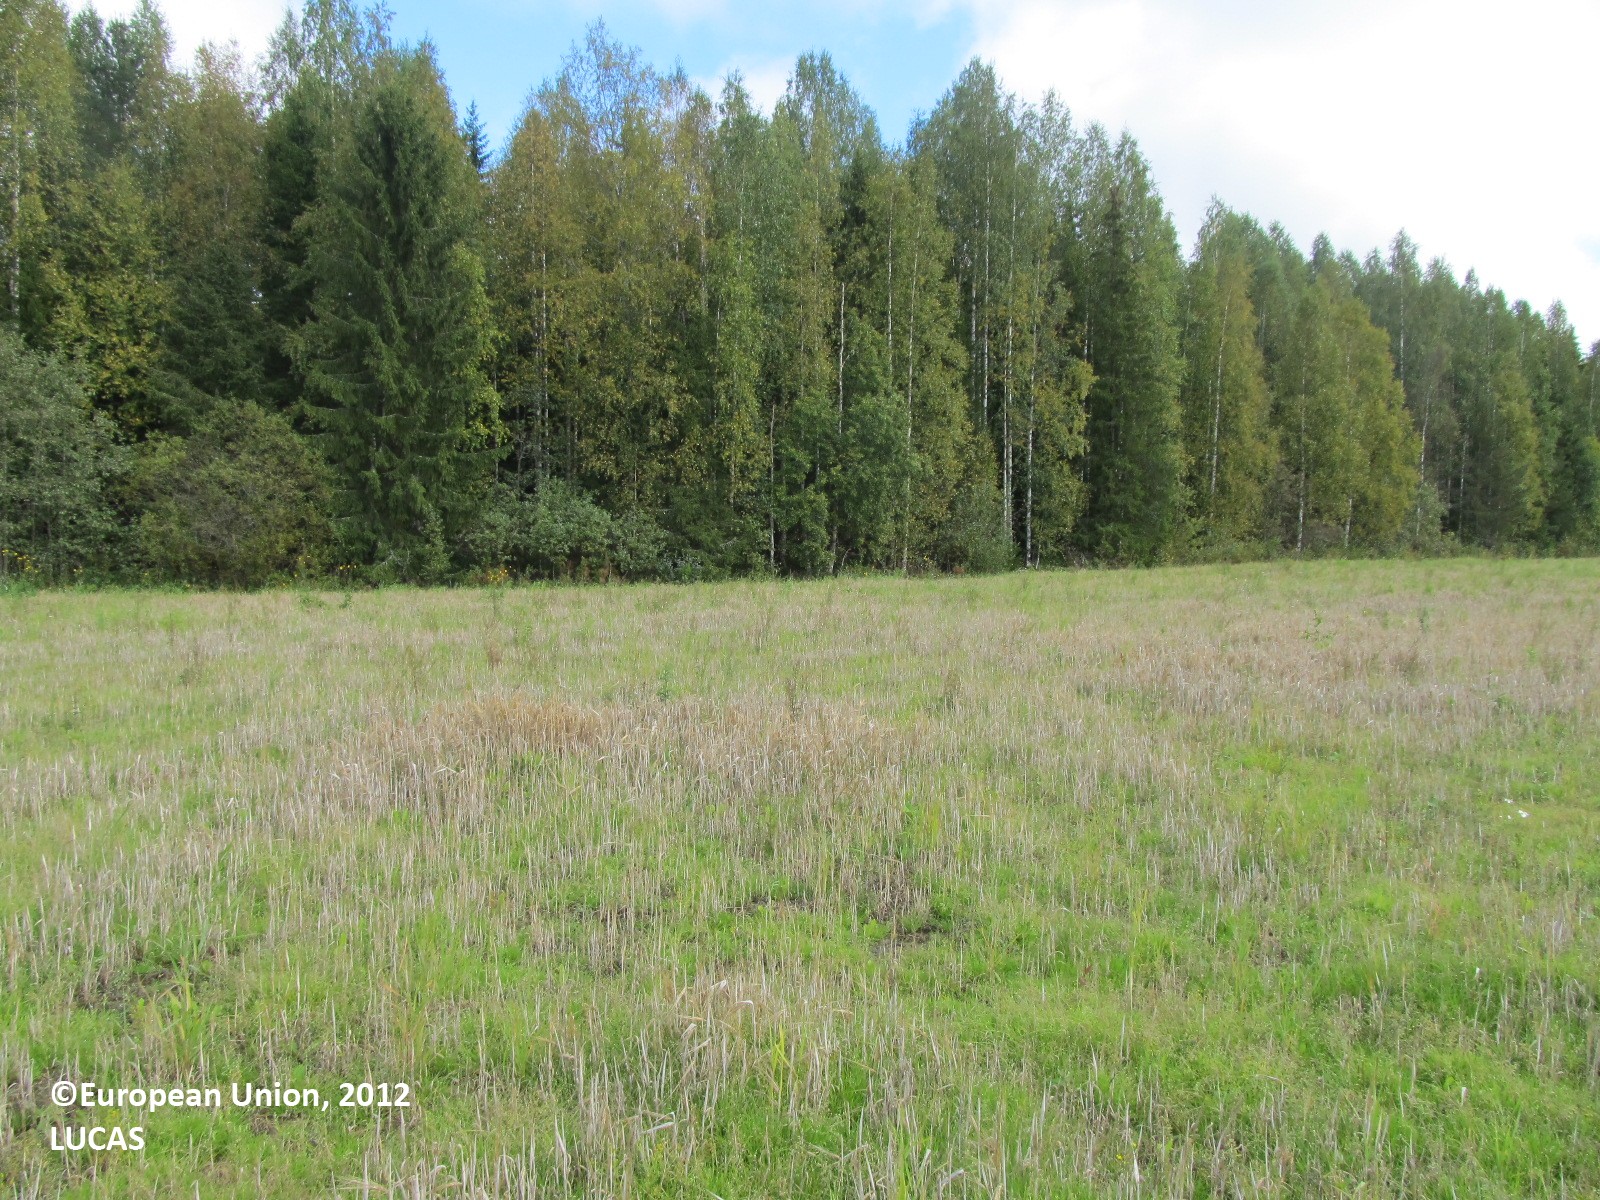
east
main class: Cropland
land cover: Barley
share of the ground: 25 - 50 %
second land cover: Grassland without tree/shrub cover
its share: 50 - 75 %
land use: Agriculture (excluding fallow land and kitchen gardens)
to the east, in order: Barley; Grassland without tree/shrub cover; Ditches and canals; Spruce dominated coniferous woodland; Ditches and canals; Oats; Ditches and canals; Oats
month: September
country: FI
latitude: 62.9376
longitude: 28.2130
